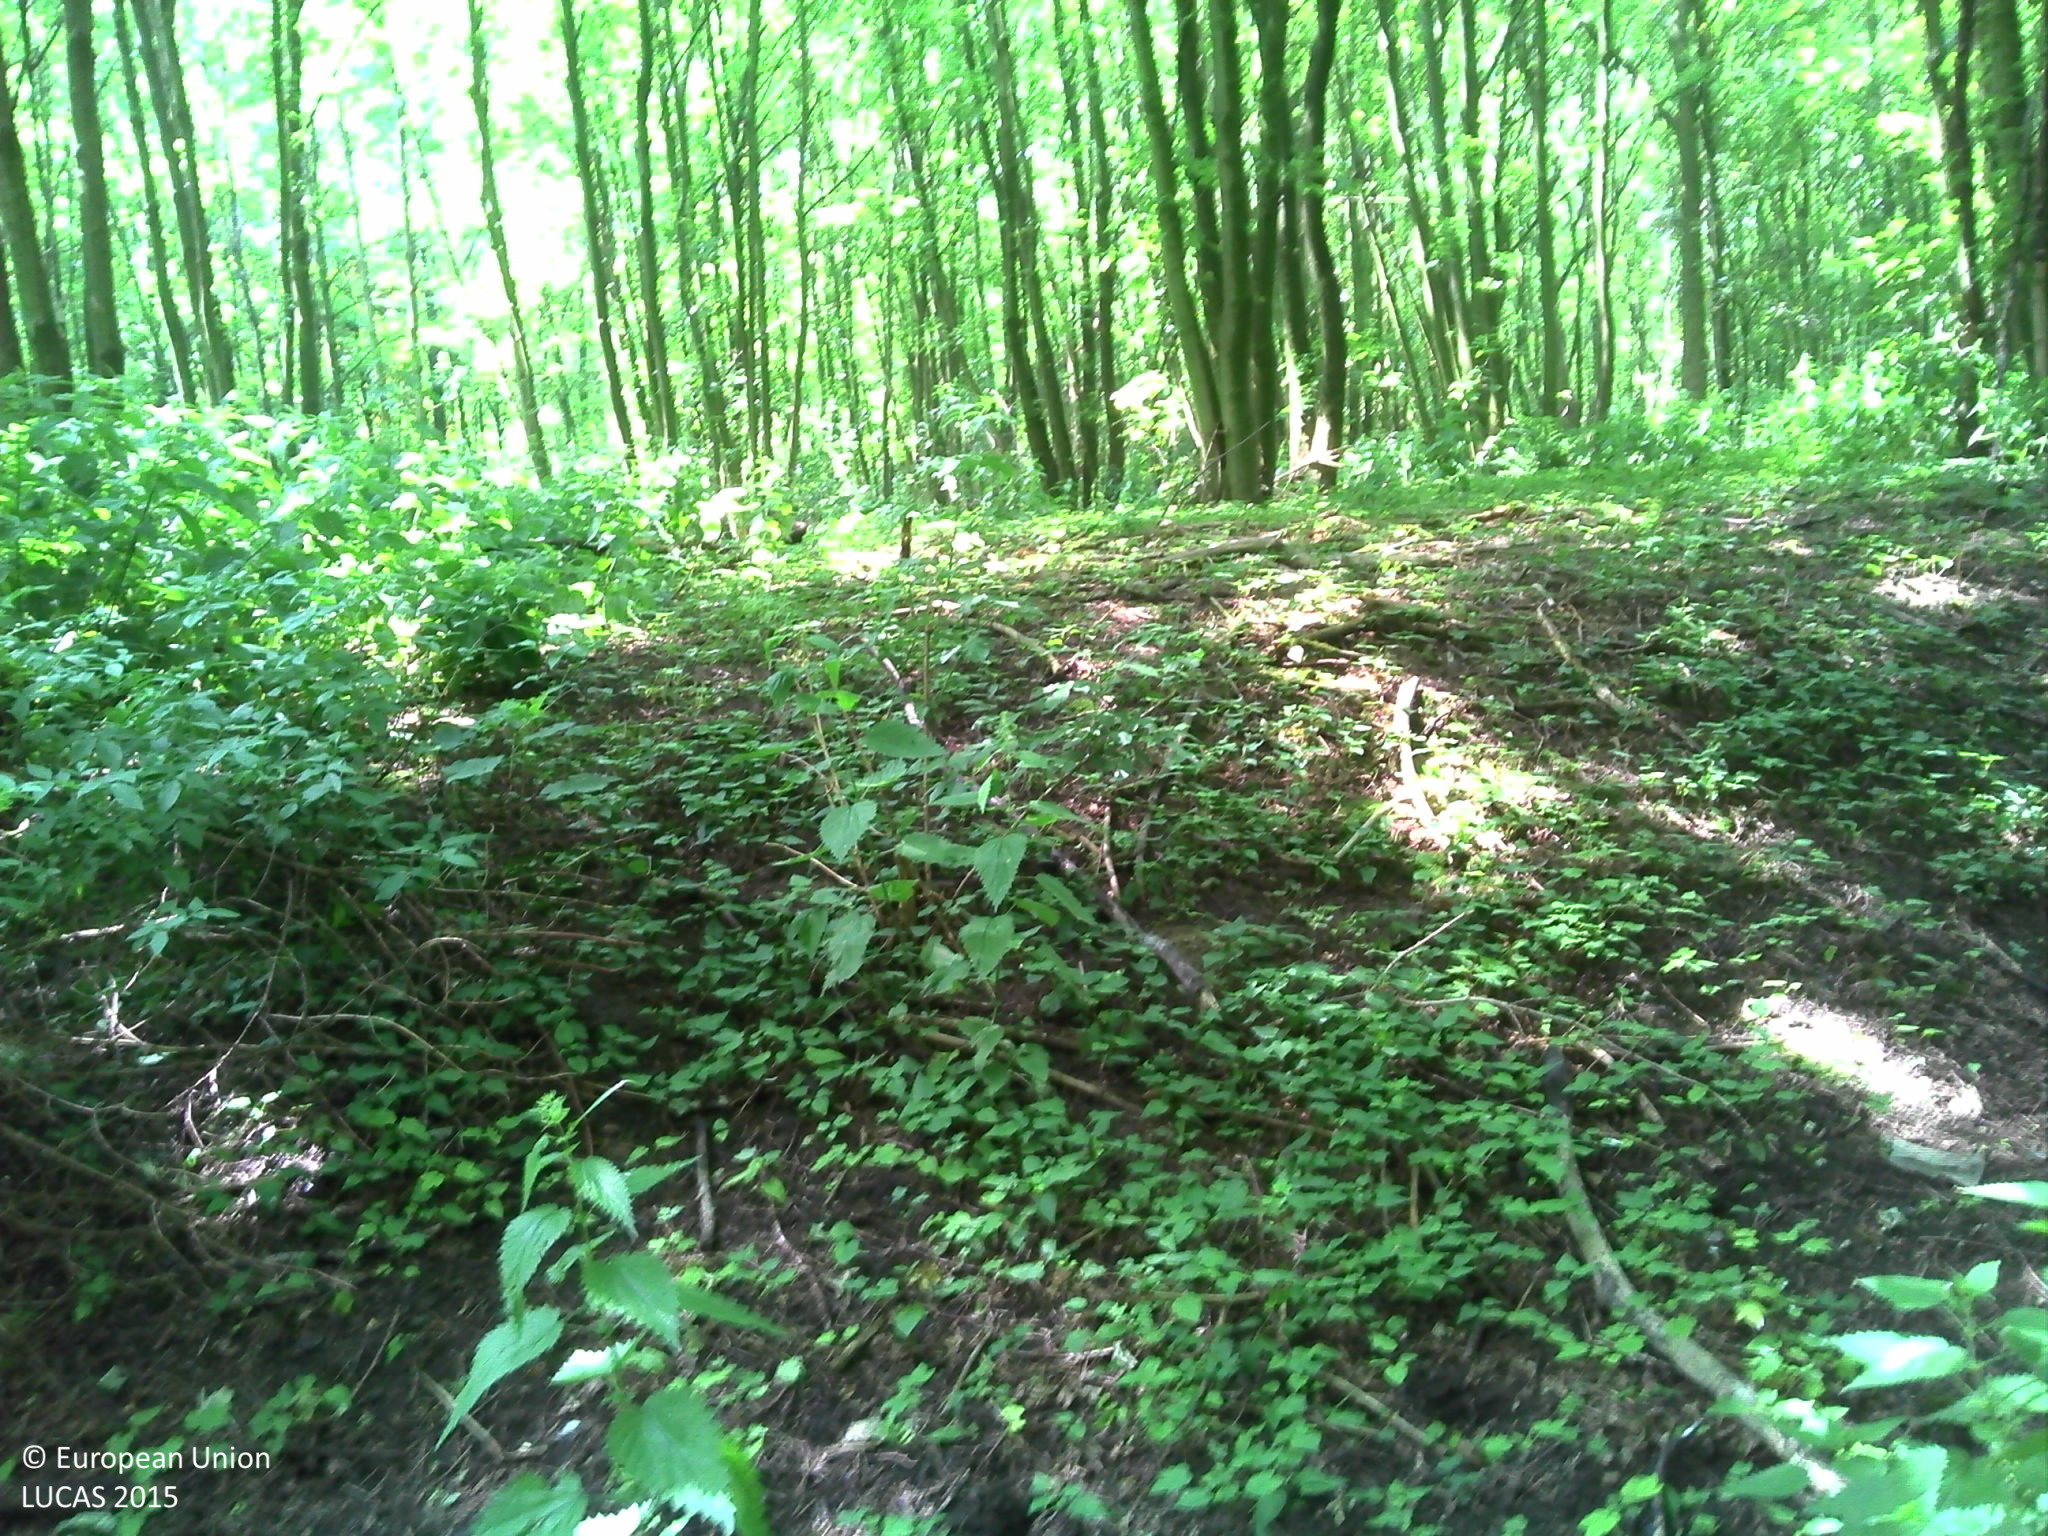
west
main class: Woodland
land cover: Broadleaved woodland
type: mesophytic deciduous forest
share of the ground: > 75 %
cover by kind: broadleaved forest trees 60 %, herbaceous plants 30 %, unconsolidated bare surface 10 %
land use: Forestry
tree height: > 5 m
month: June
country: BE
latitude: 50.4848
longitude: 3.8063
